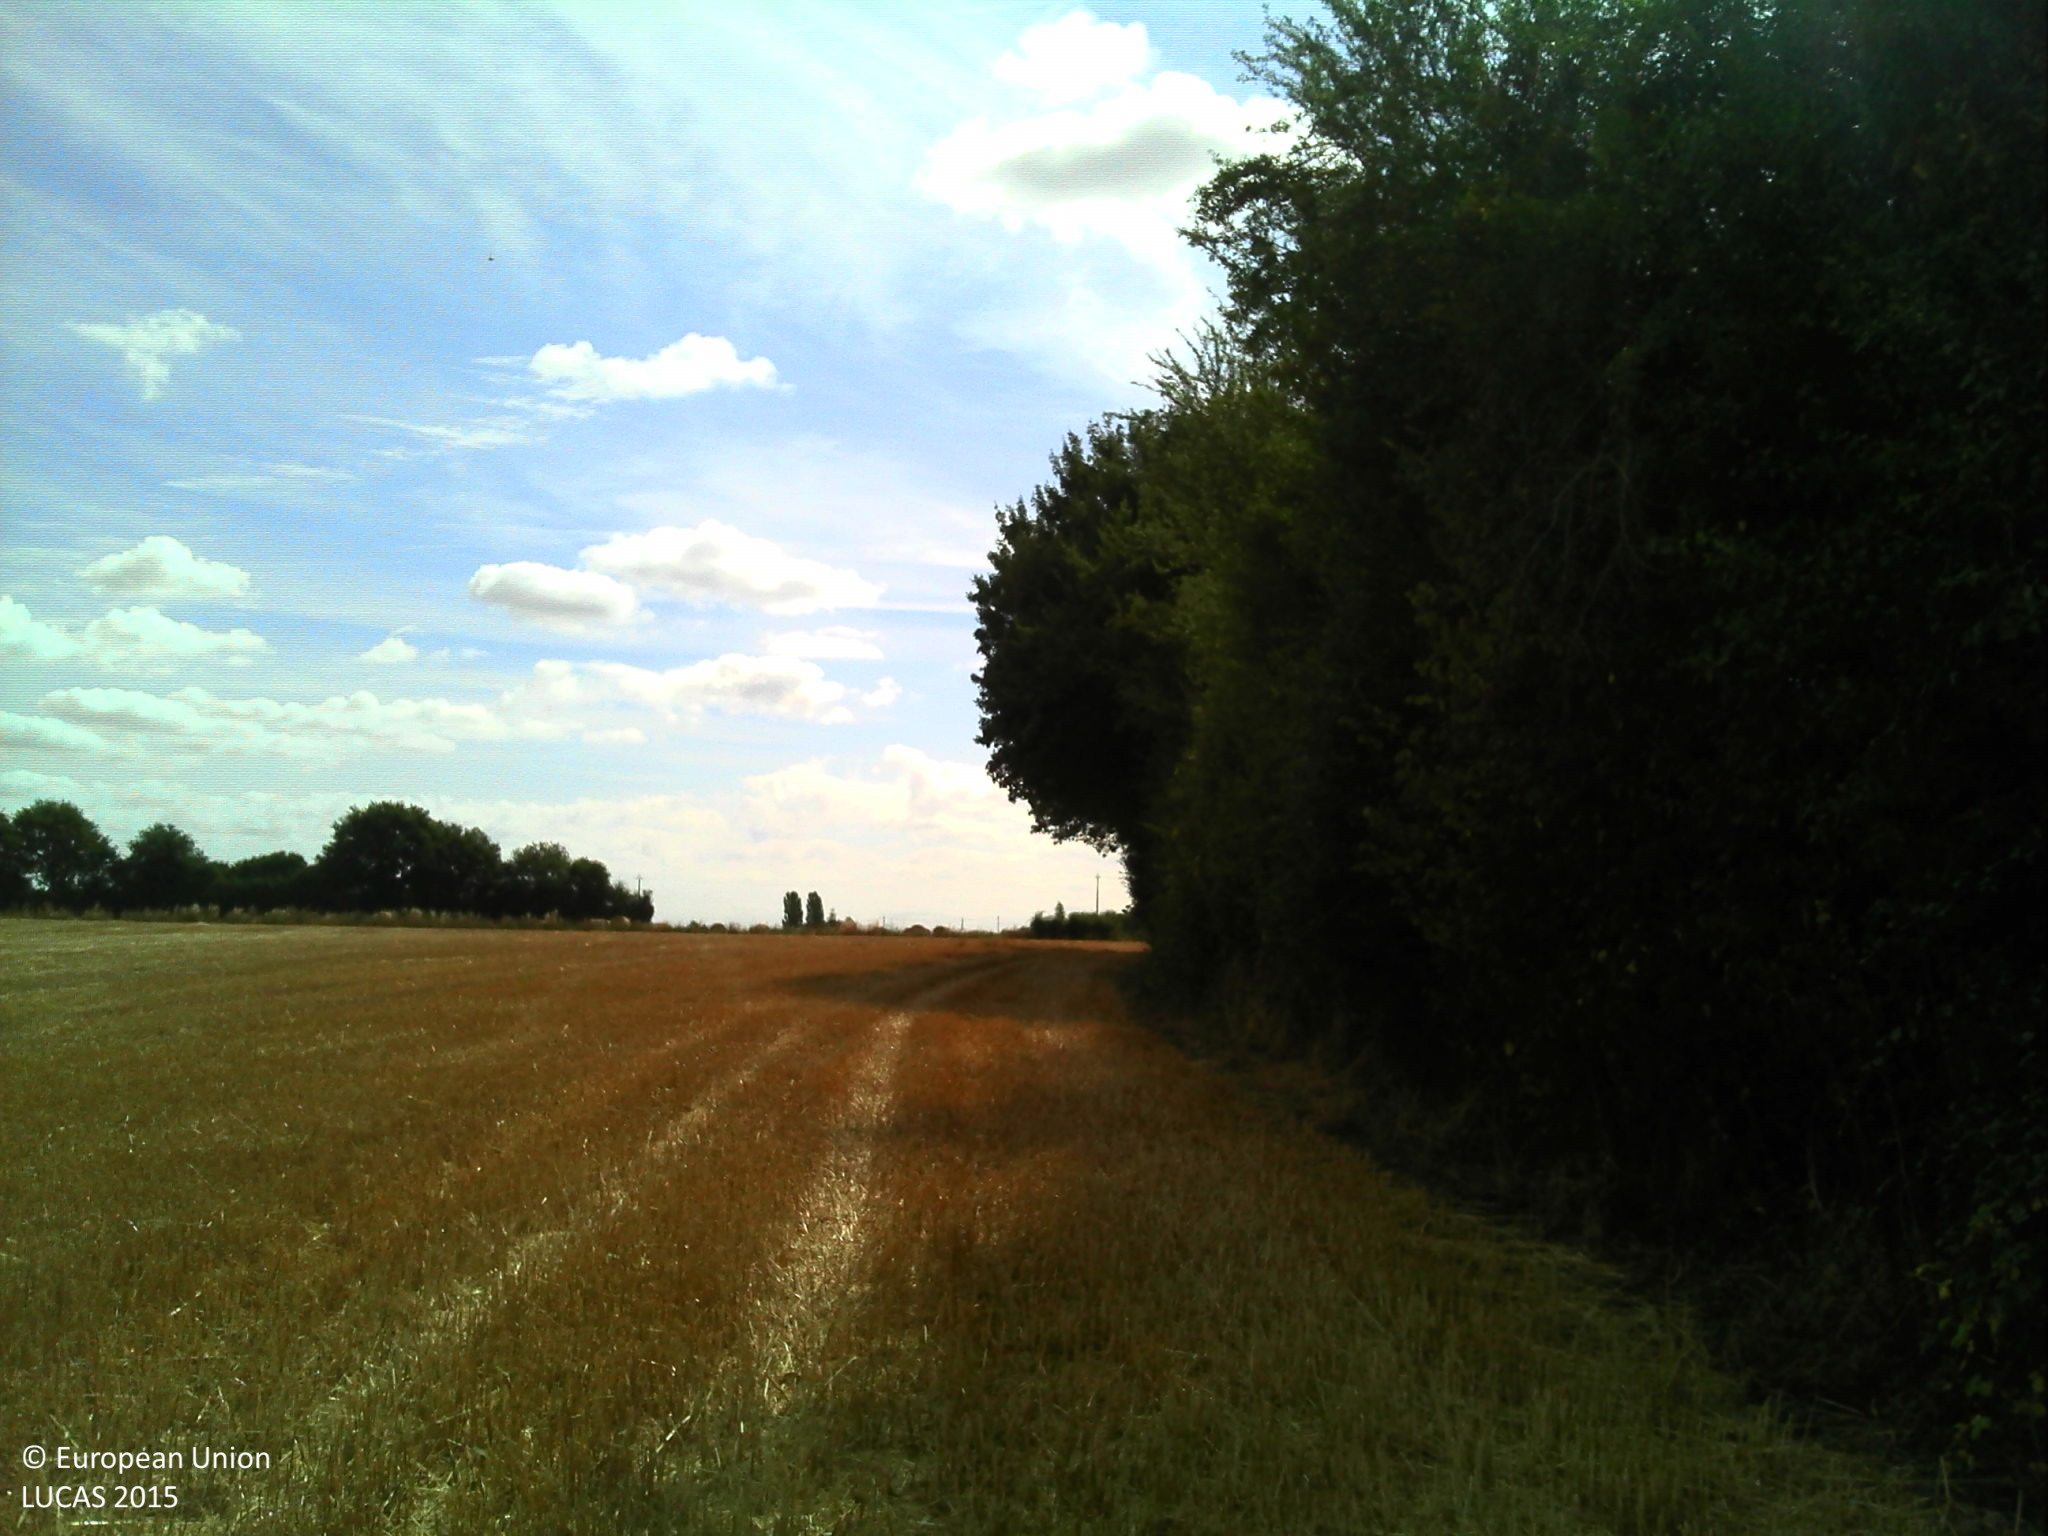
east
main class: Cropland
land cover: Common wheat
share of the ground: > 75 %
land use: Agriculture (excluding fallow land and kitchen gardens)
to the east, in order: Common wheat; Abandoned hedges; Common wheat
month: July
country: FR
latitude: 47.8603
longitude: 0.6351
